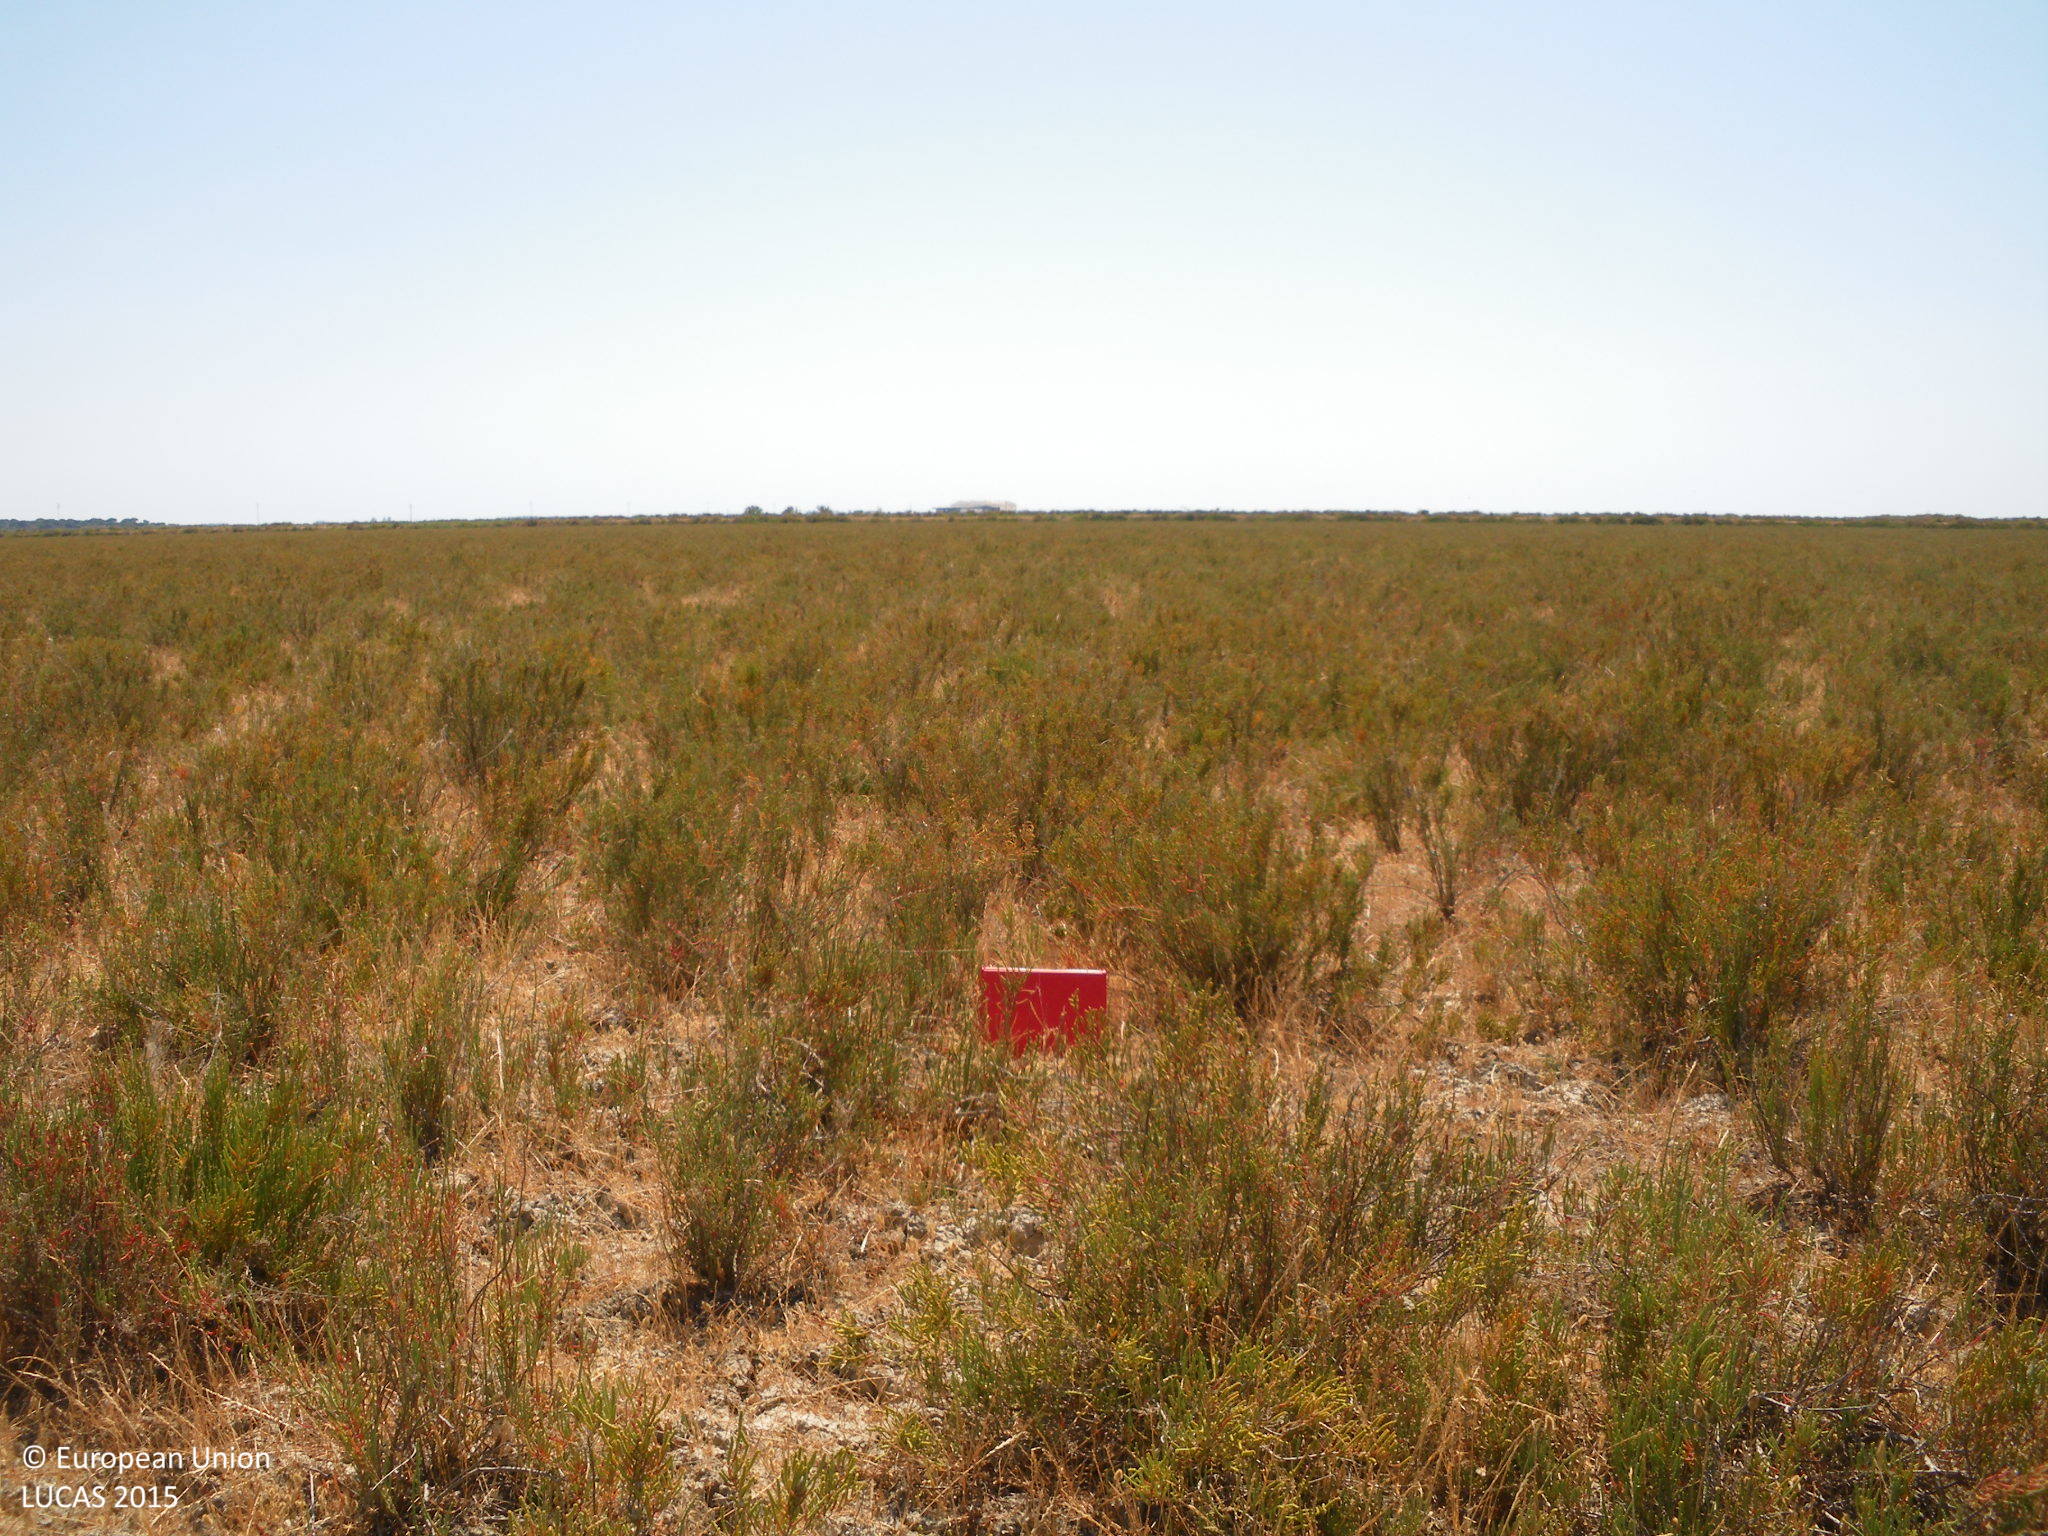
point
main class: Shrubland
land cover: Shrubland without tree cover
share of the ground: 50 - 75 %
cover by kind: shrubs 50 %, herbaceous plants 35 %, unconsolidated bare surface 15 %
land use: Agriculture (excluding fallow land and kitchen gardens)
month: May
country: ES
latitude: 36.8846
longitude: -6.2993
